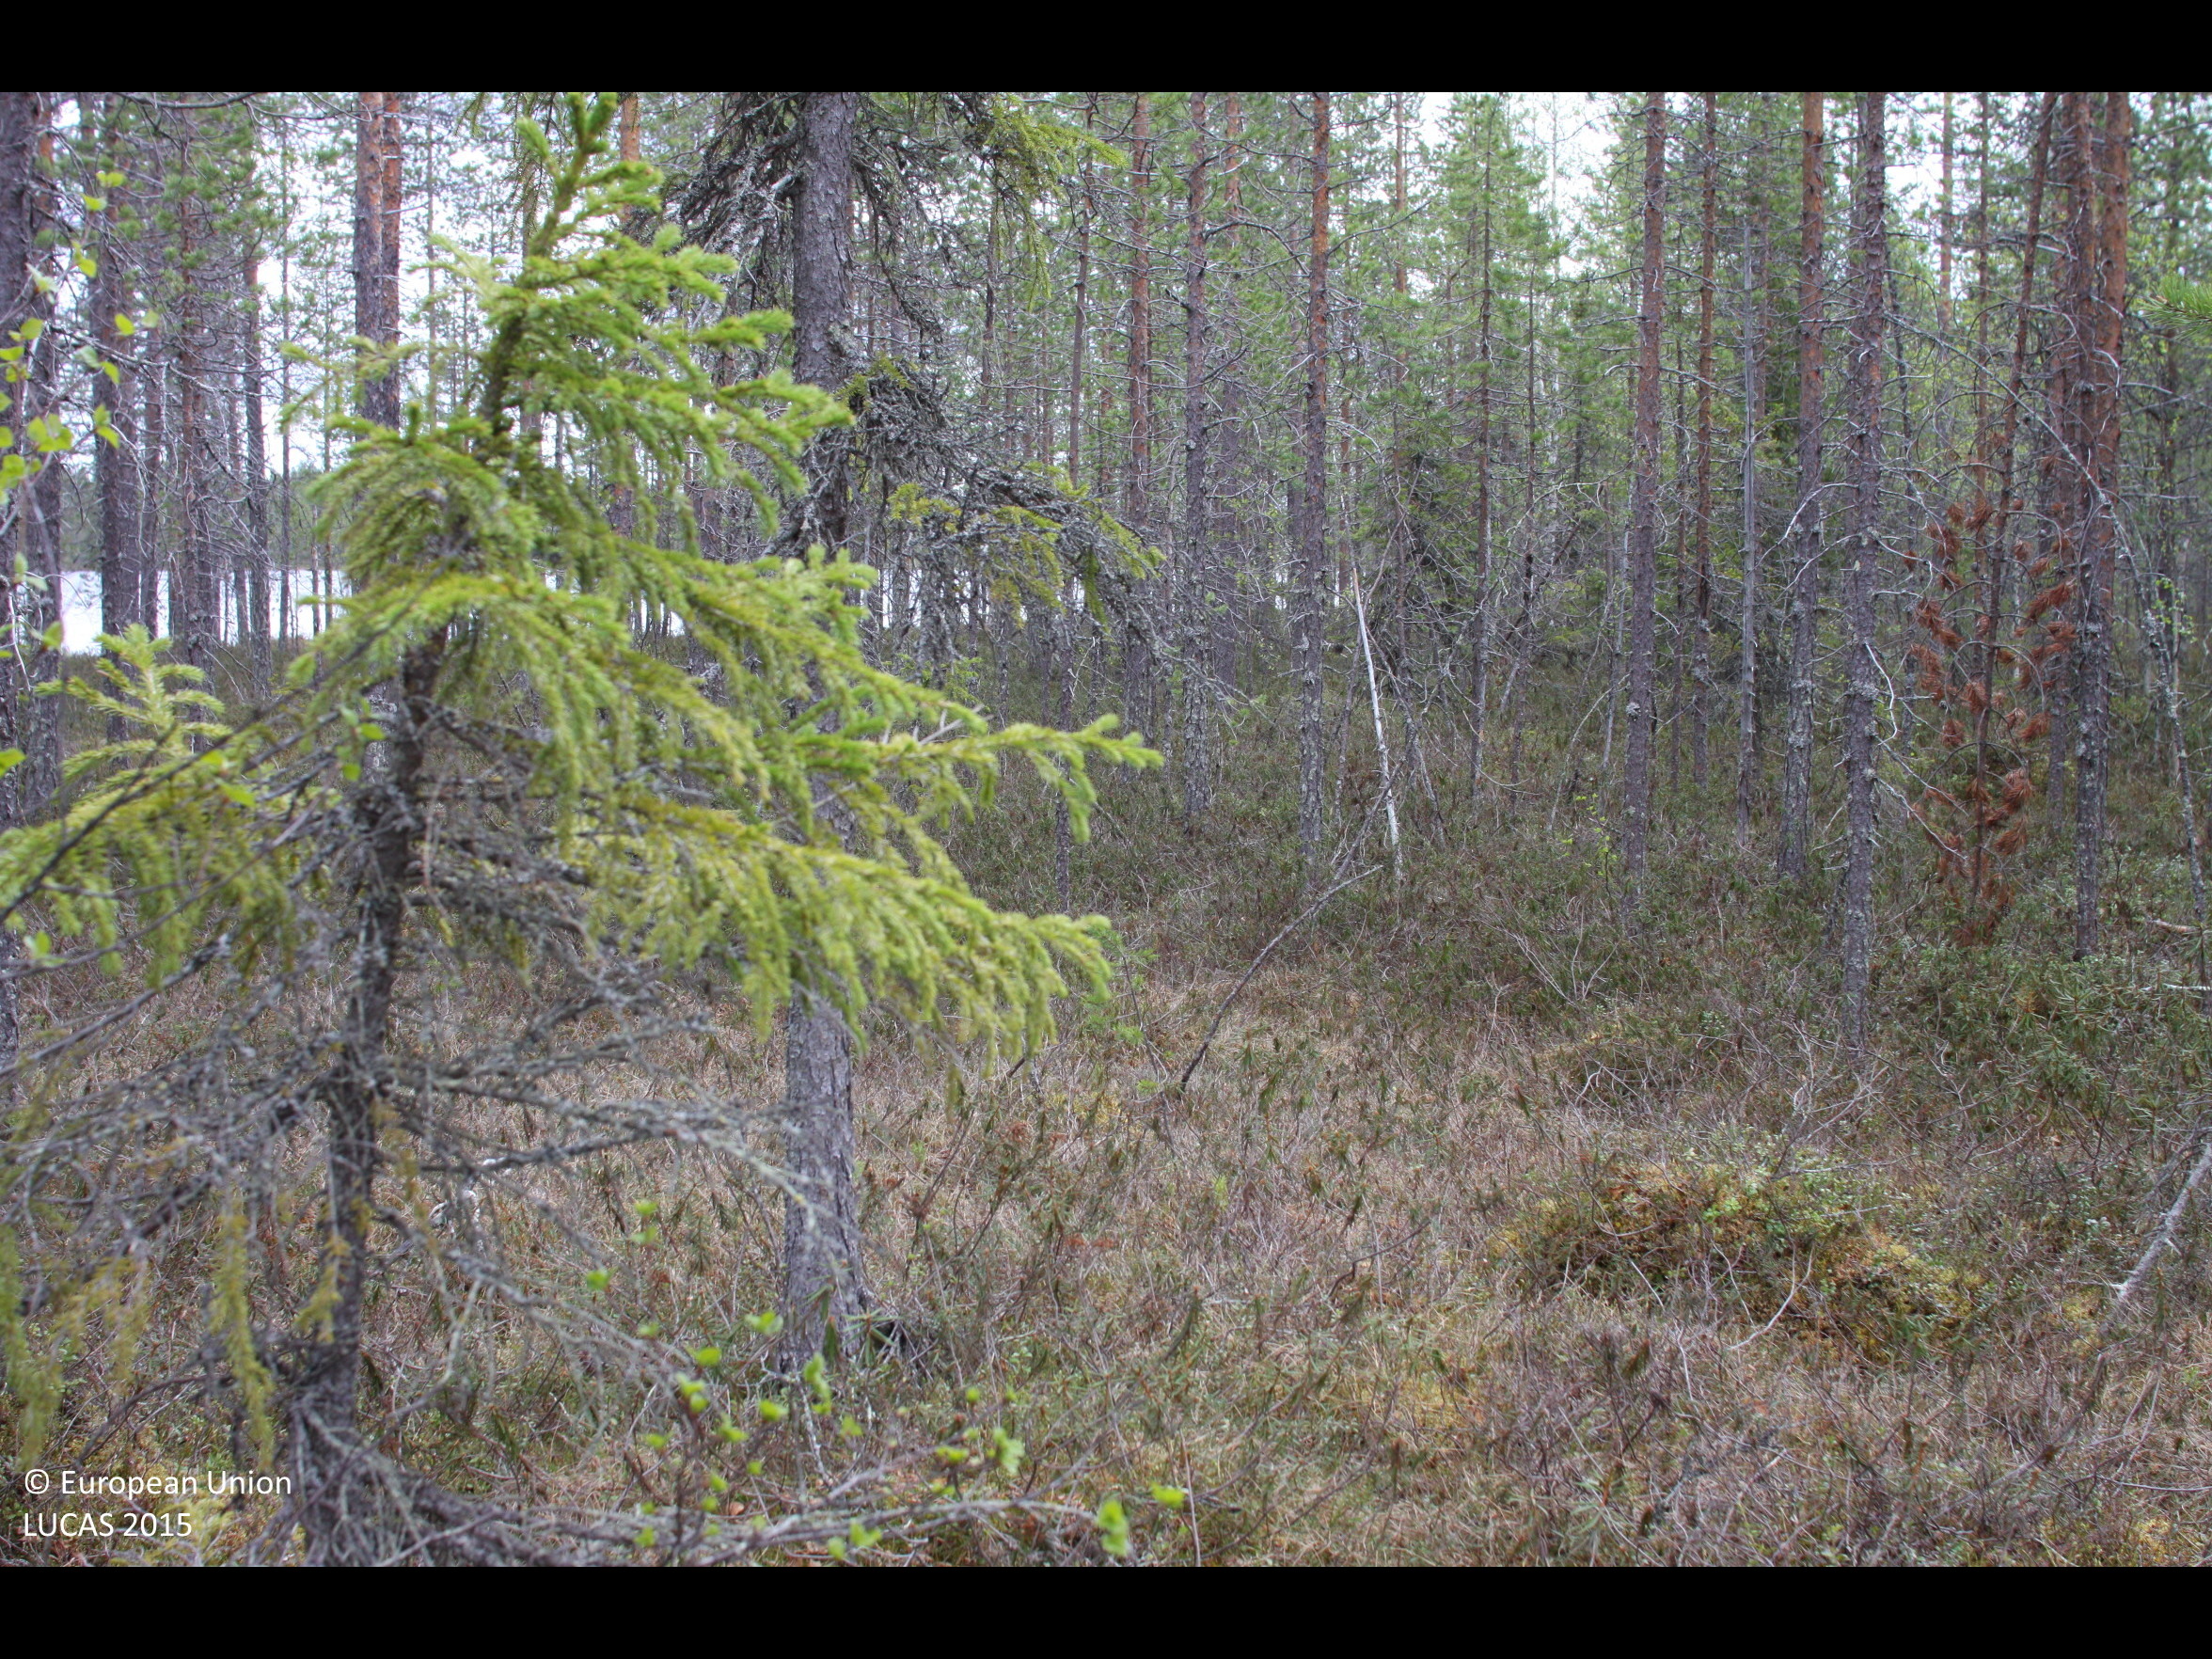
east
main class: Woodland
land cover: Pine dominated coniferous woodland
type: boreal forest
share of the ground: 50 - 75 %
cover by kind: coniferous forest trees 65 %, shrubs 25 %, herbaceous plants 5 %, lichens and mosses 5 %
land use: Forestry
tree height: > 5 m
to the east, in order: Pine dominated coniferous woodland; Ditches and canals; Pine dominated coniferous woodland; Inland fresh water bodies
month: June
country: FI
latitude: 66.2052
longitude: 27.8776
